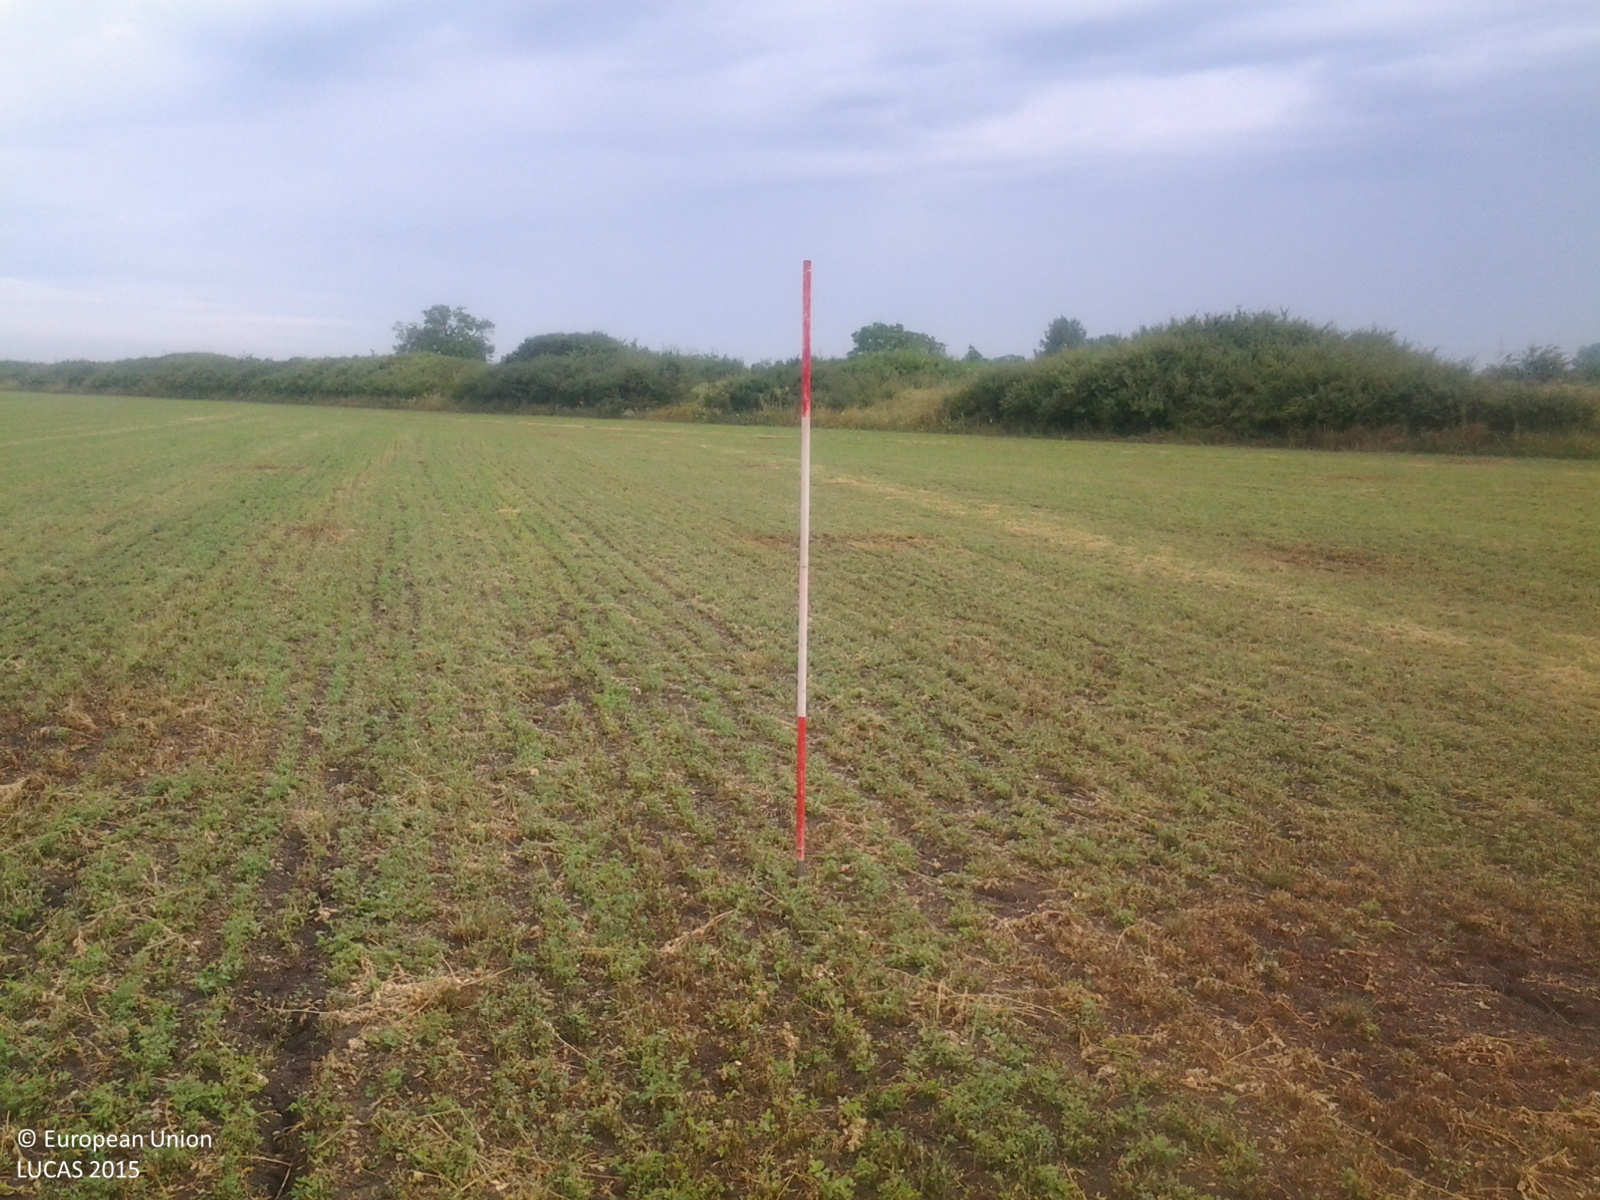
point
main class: Cropland
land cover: Lucerne
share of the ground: > 75 %
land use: Agriculture (excluding fallow land and kitchen gardens)
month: August
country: HU
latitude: 46.9202
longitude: 21.2380
